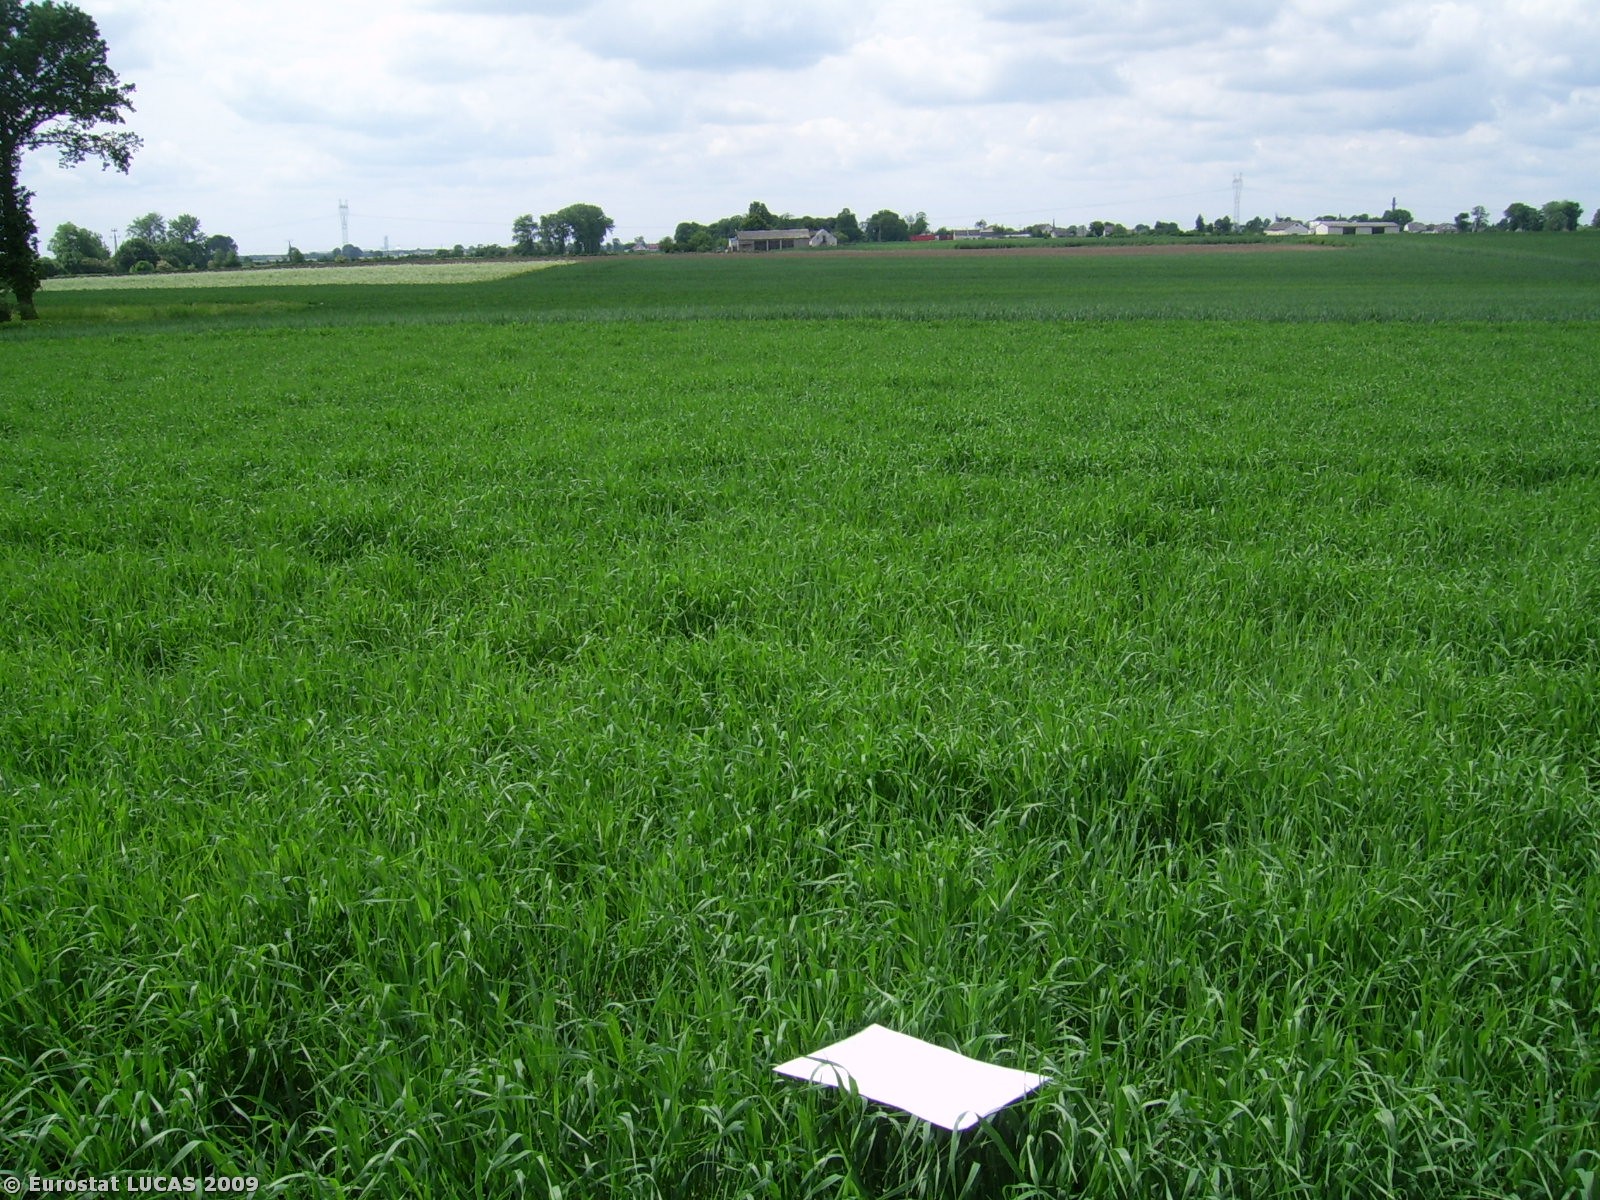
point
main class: Cropland
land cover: Barley
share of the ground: > 75 %
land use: Agriculture (excluding fallow land and kitchen gardens)
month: May
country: PL
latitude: 52.8546
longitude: 18.1695
